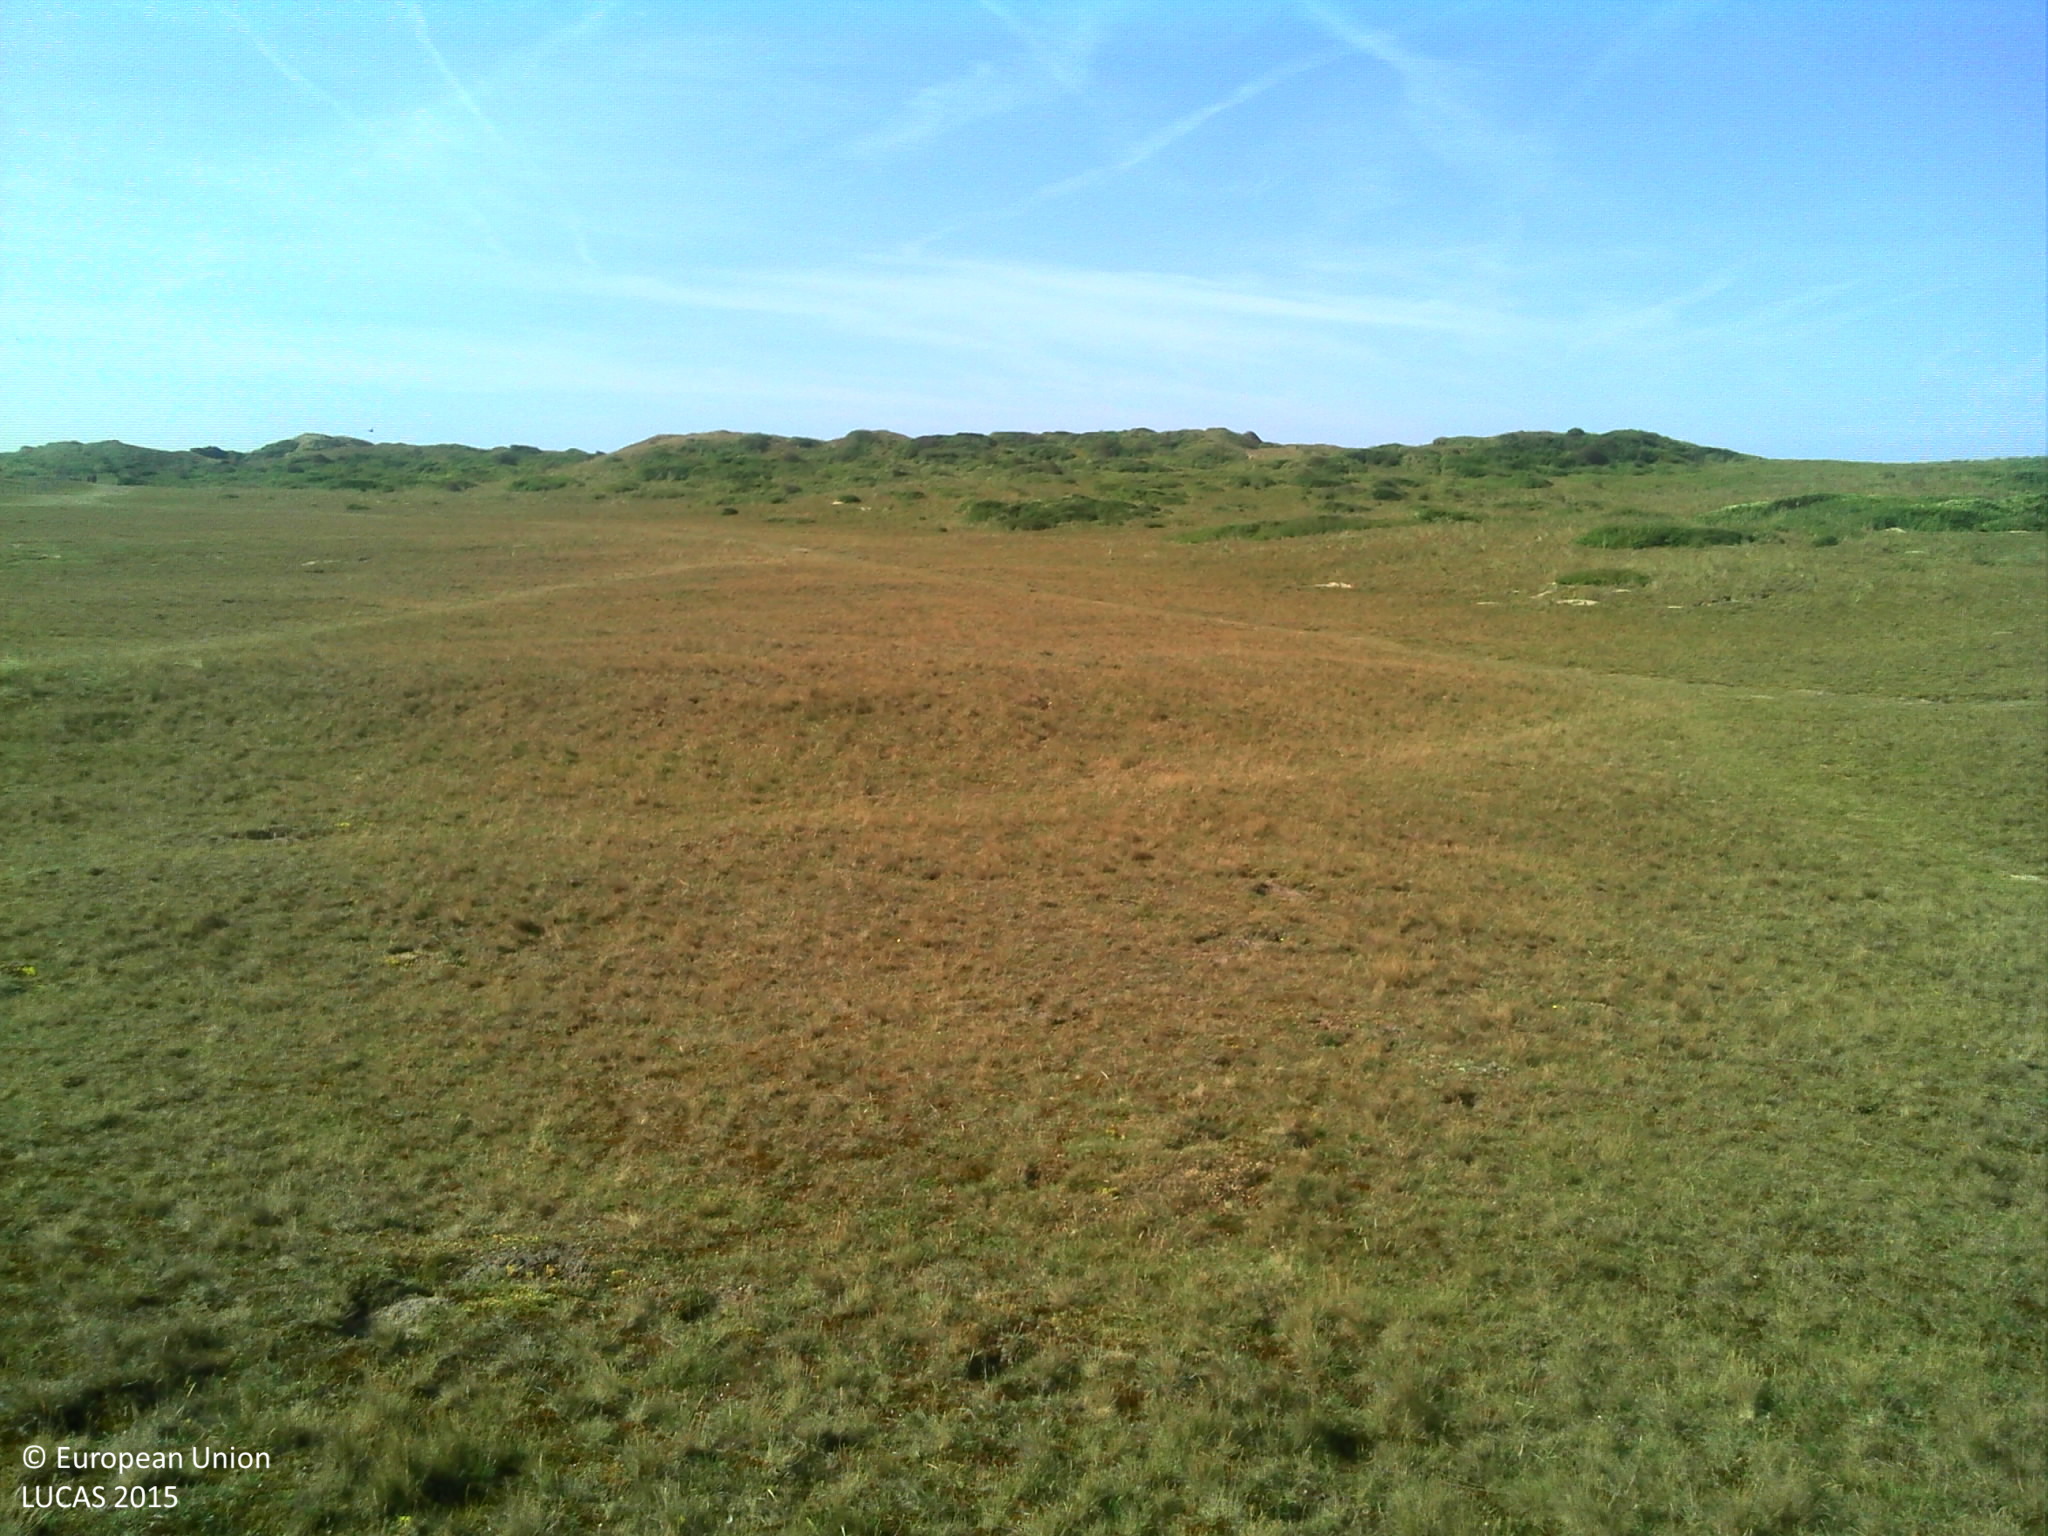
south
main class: Grassland
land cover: Grassland without tree/shrub cover
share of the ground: > 75 %
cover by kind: herbaceous plants 95 %, shrubs 5 %
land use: Amenities, museums, leisure
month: June
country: FR
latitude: 49.3244
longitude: -1.7056
